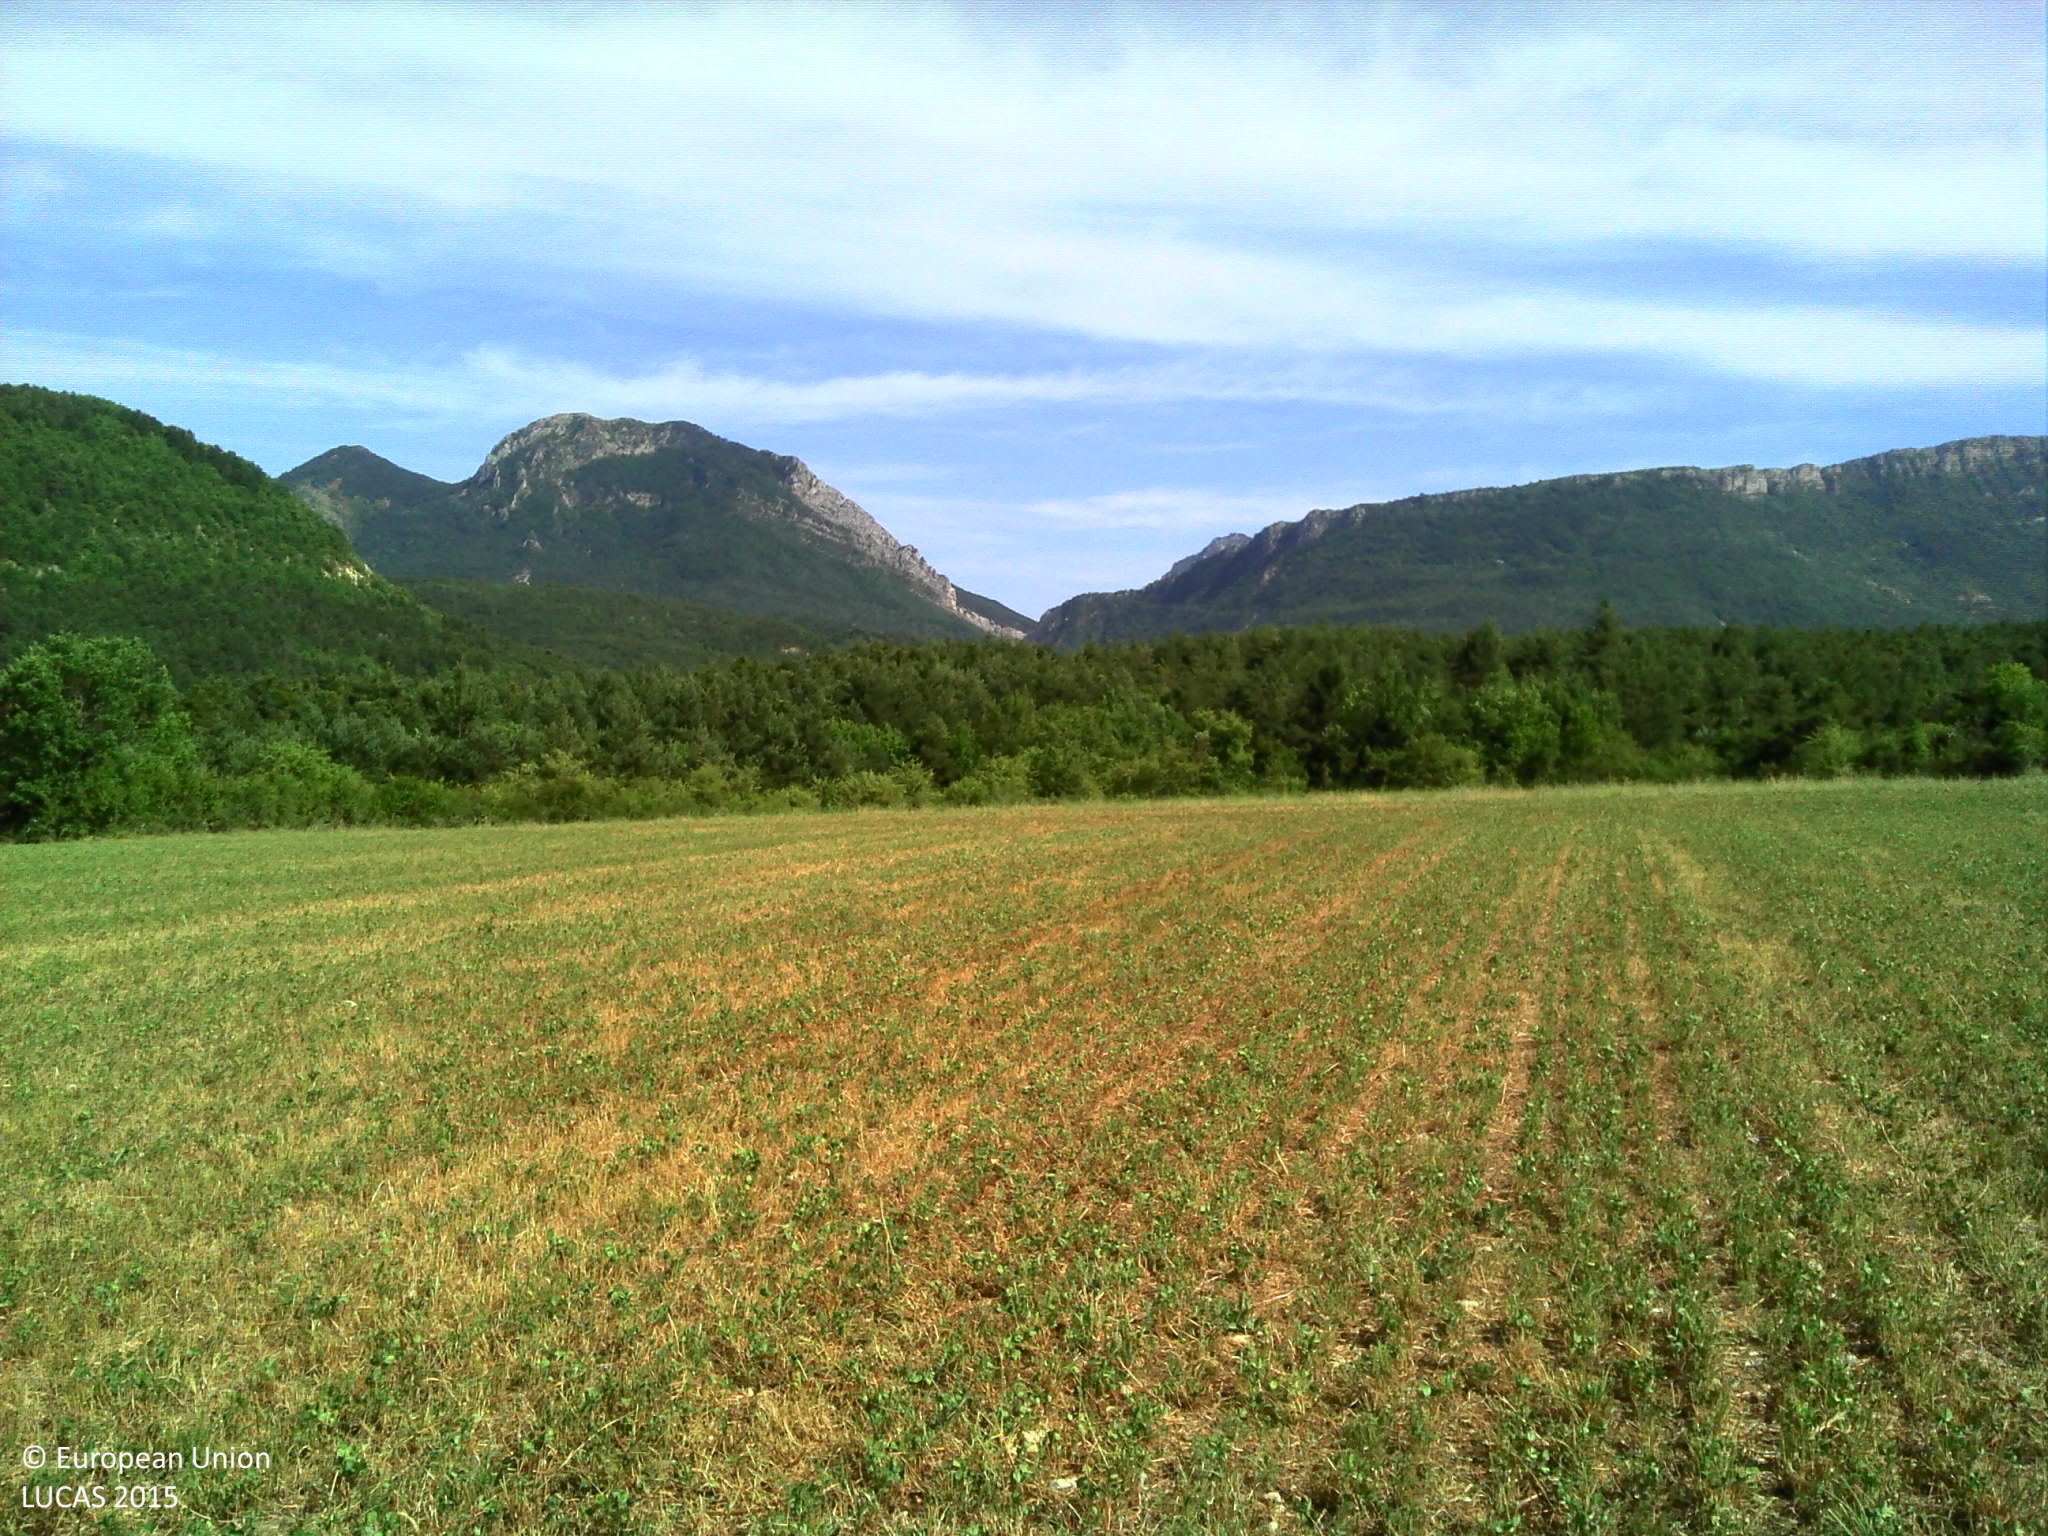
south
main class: Cropland
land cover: Temporary grasslands
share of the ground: > 75 %
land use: Agriculture (excluding fallow land and kitchen gardens)
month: July
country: FR
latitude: 43.9093
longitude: 6.4091
